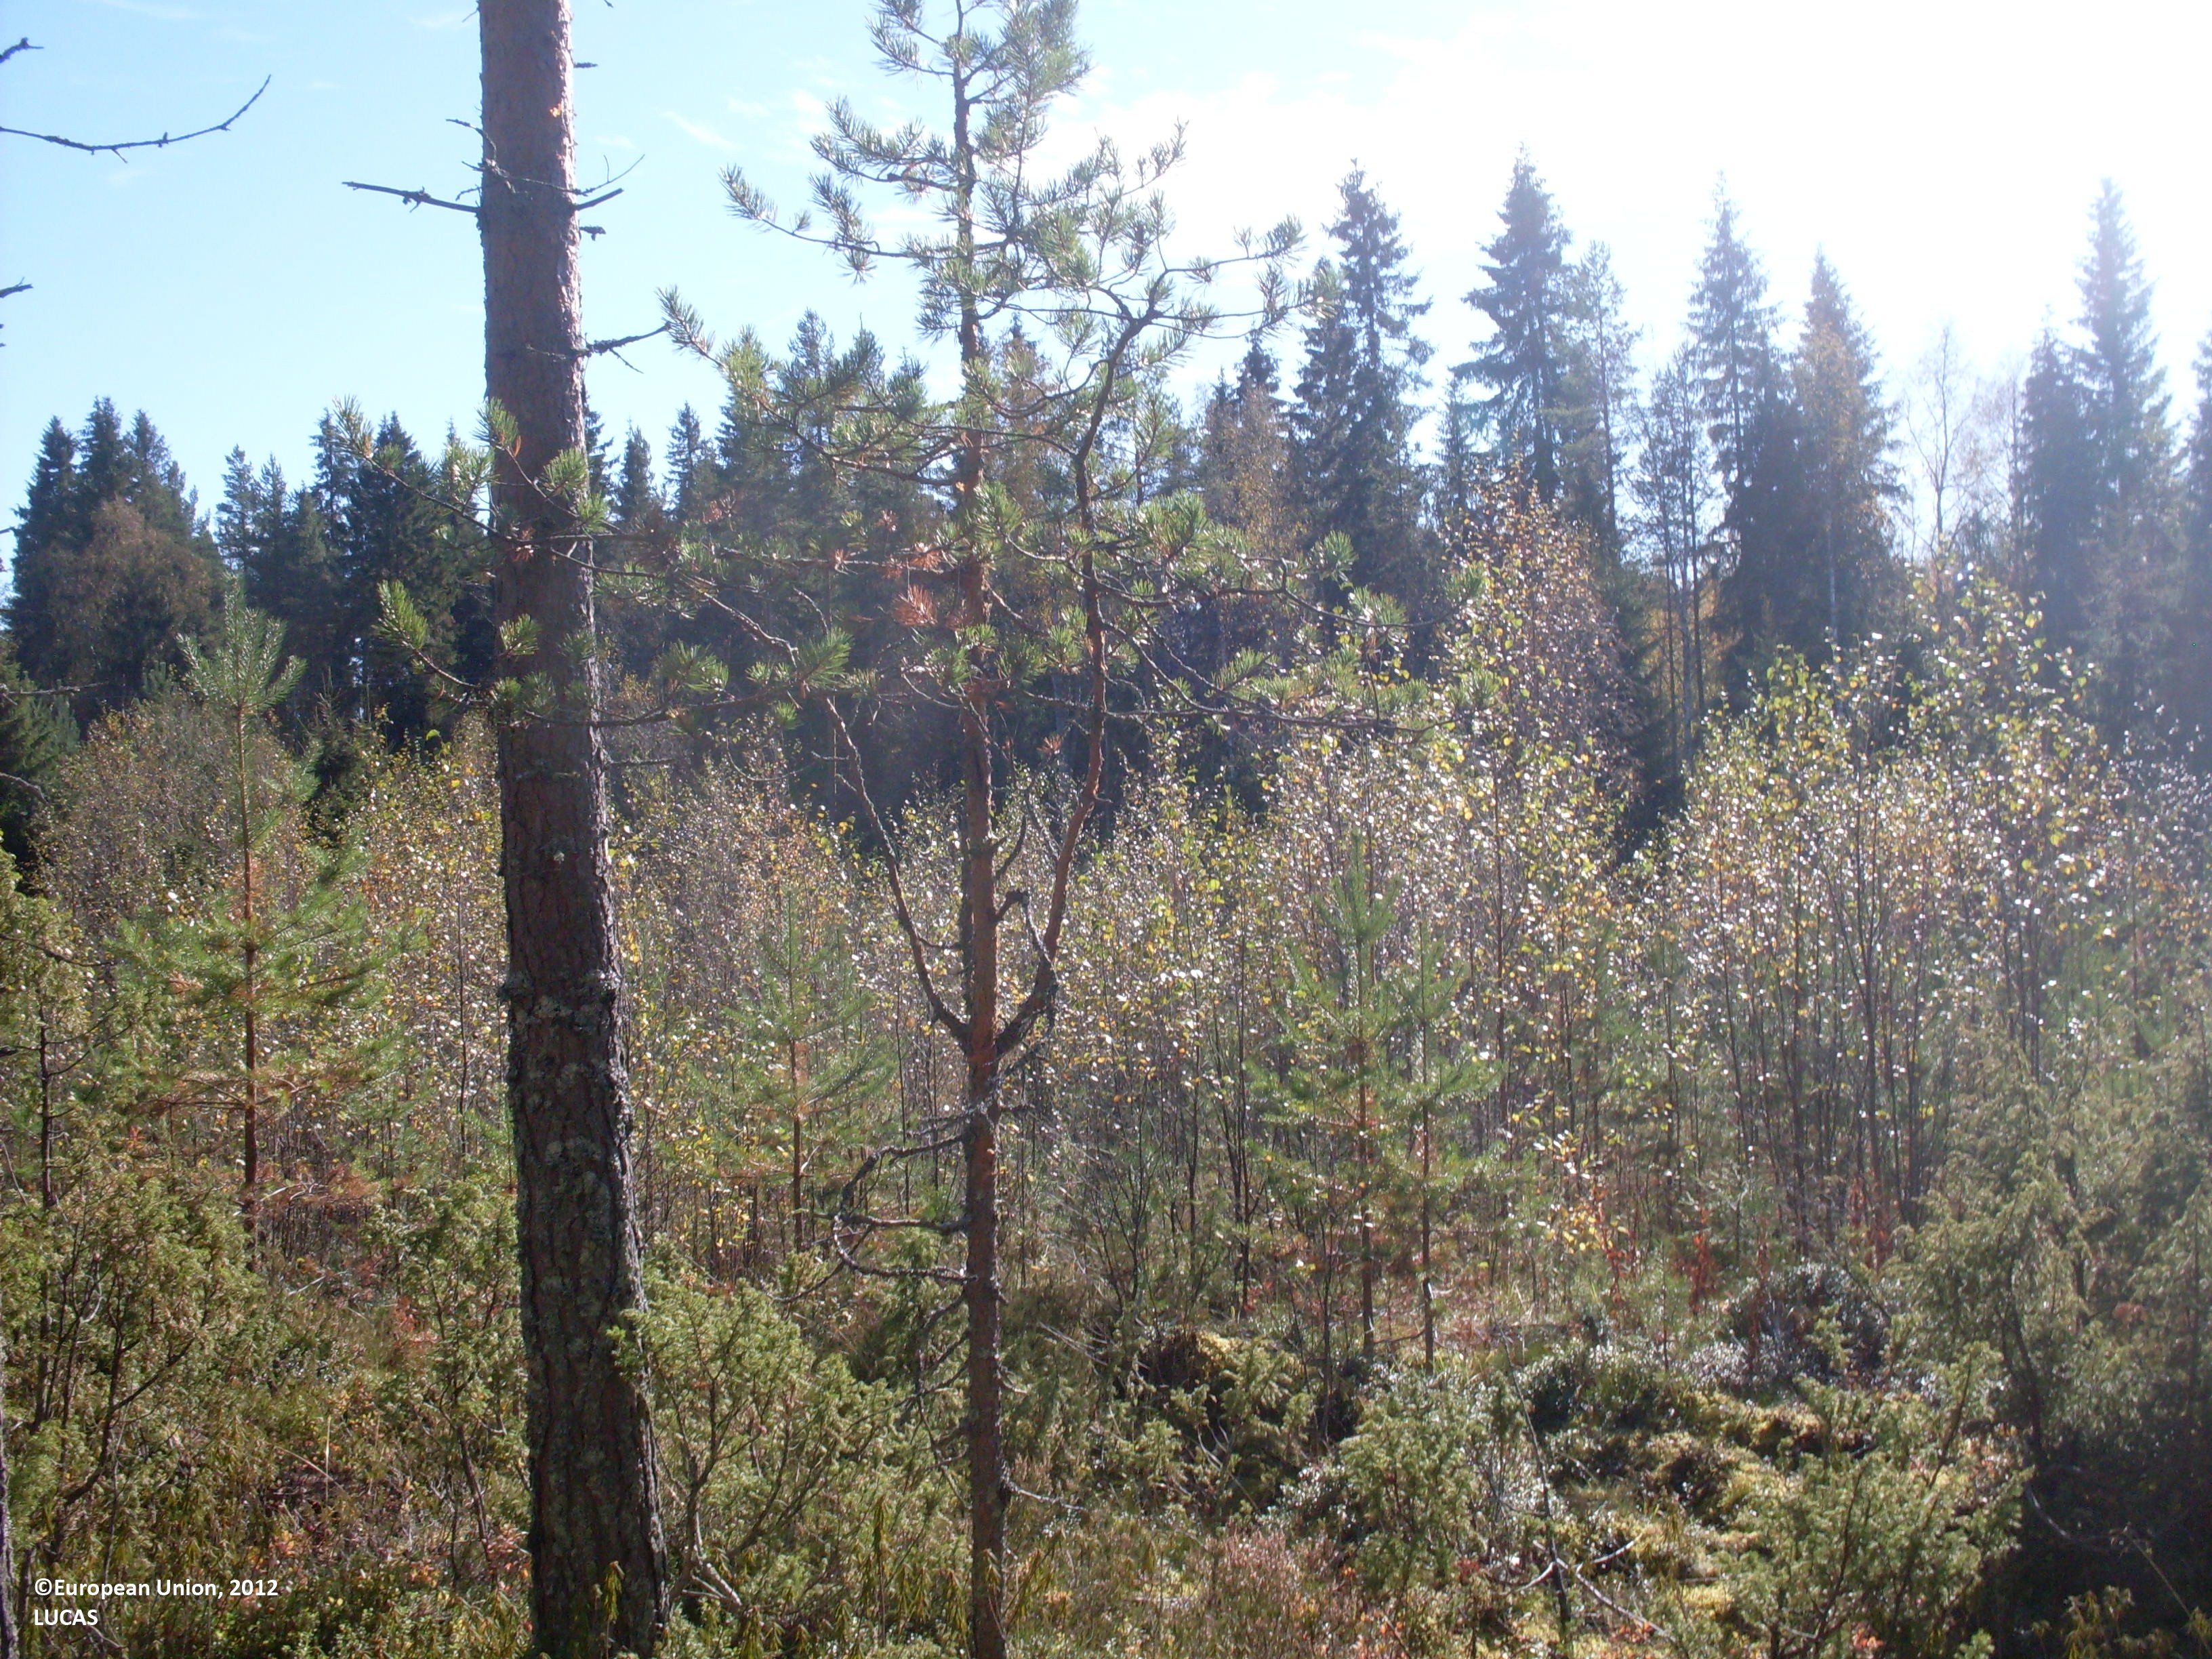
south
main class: Woodland
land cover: Pine dominated mixed woodland
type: boreal forest
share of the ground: > 75 %
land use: Forestry
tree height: > 5 m
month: September
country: FI
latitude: 64.3656
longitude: 28.5986
